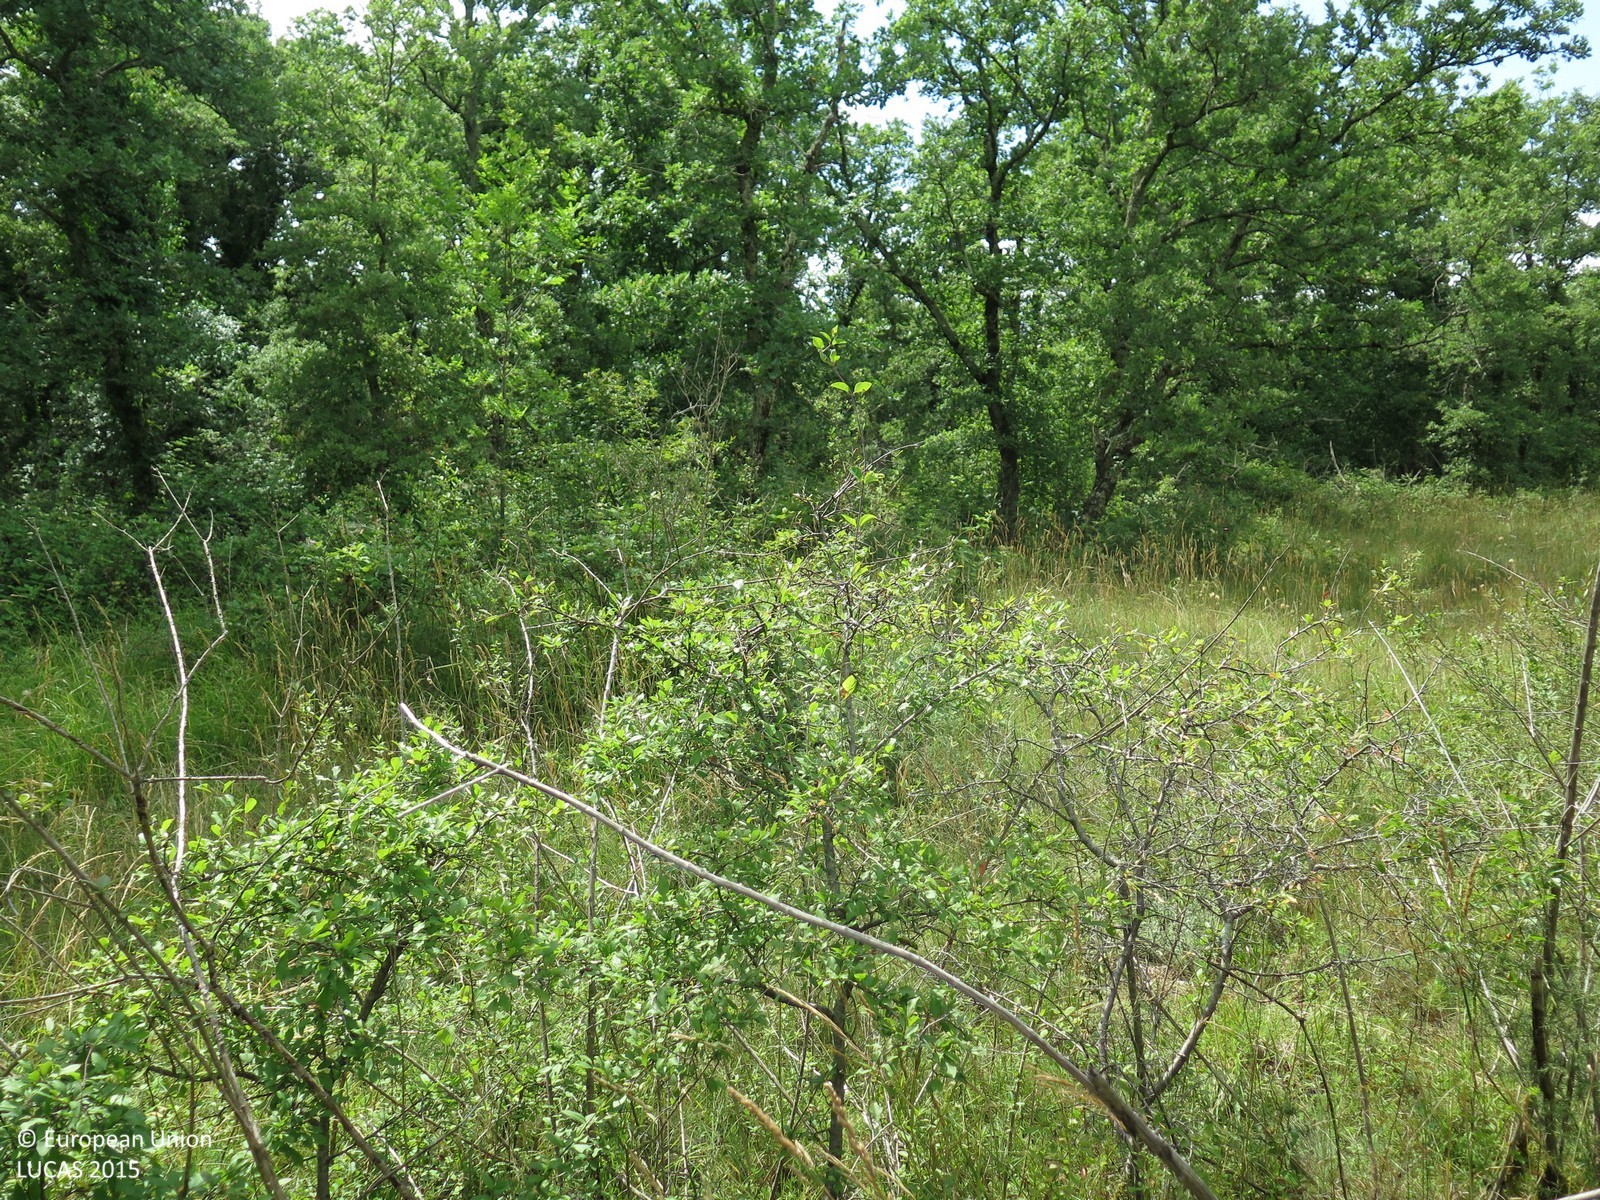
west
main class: Shrubland
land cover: Shrubland with sparse tree cover
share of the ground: > 75 %
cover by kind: shrubs 90 %, broadleaved forest trees 5 %, herbaceous plants 5 %
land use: Semi-natural and natural areas not in use
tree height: > 5 m
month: June
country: HR
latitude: 45.2753
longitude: 13.7553
